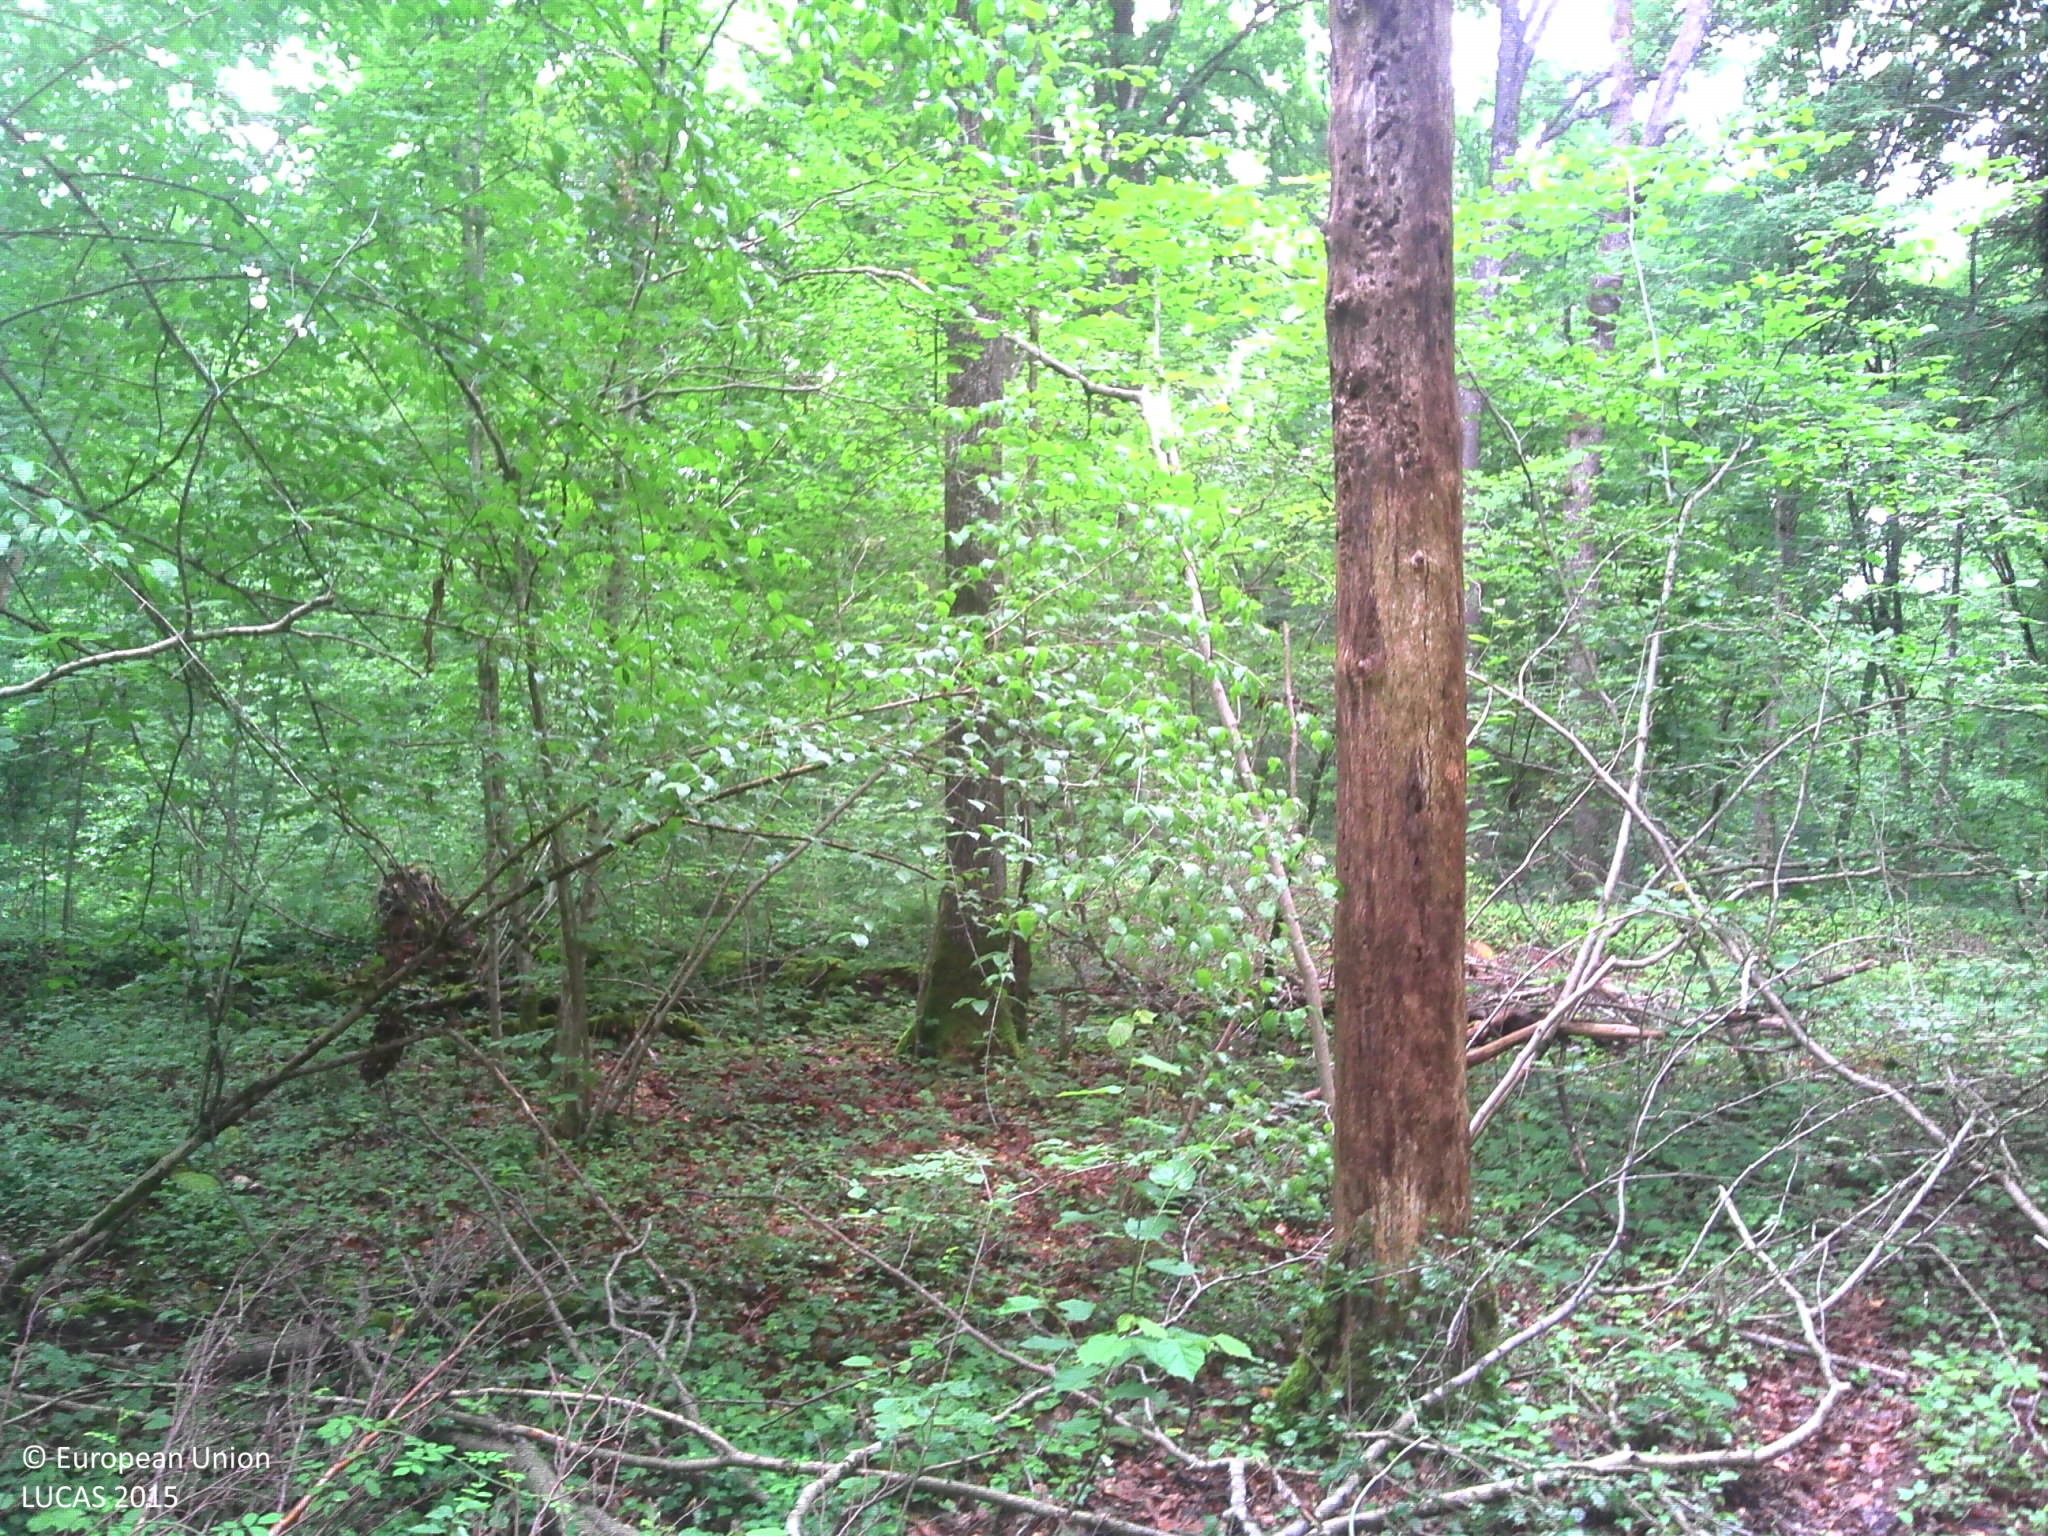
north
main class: Woodland
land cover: Broadleaved woodland
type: mesophytic deciduous forest
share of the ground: > 75 %
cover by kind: broadleaved forest trees 90 %, herbaceous plants 10 %
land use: Forestry
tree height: > 5 m
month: June
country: FR
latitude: 48.2173
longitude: 4.9785
